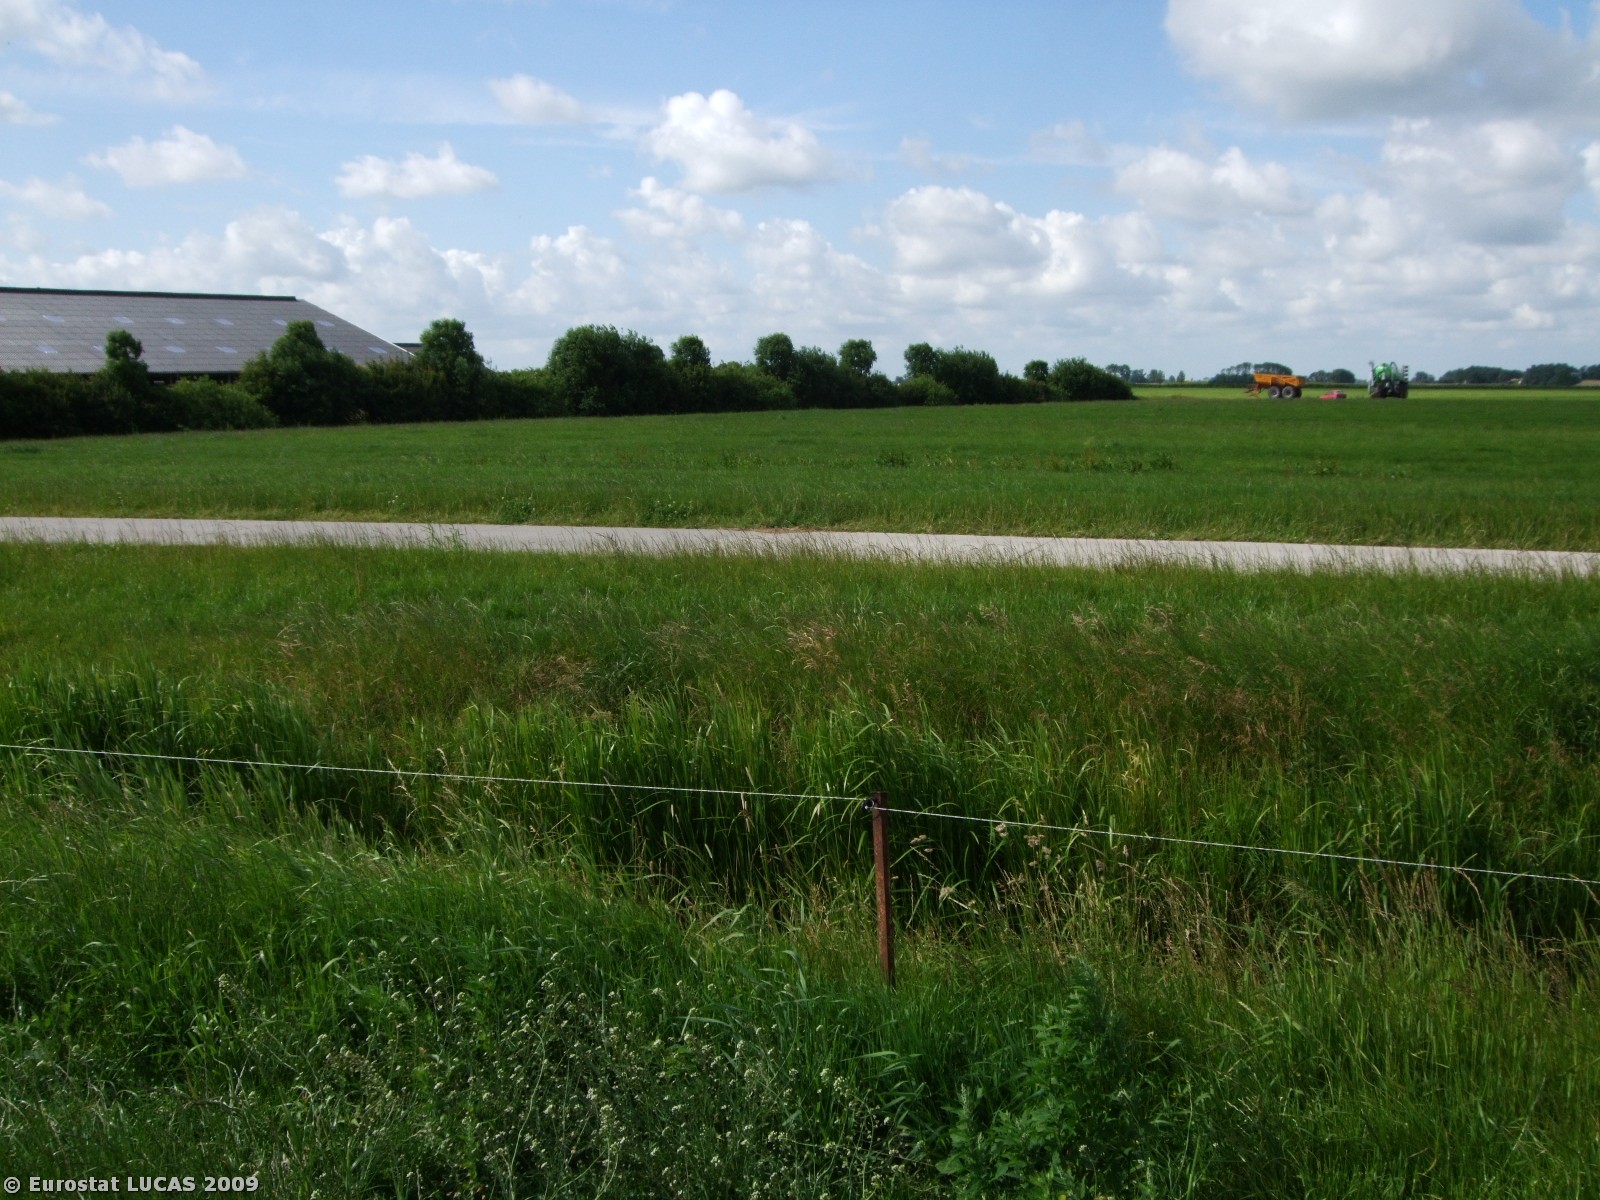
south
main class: Grassland
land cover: Grassland without tree/shrub cover
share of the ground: > 75 %
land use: Agriculture (excluding fallow land and kitchen gardens)
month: June
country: NL
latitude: 53.0530
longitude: 5.6277
